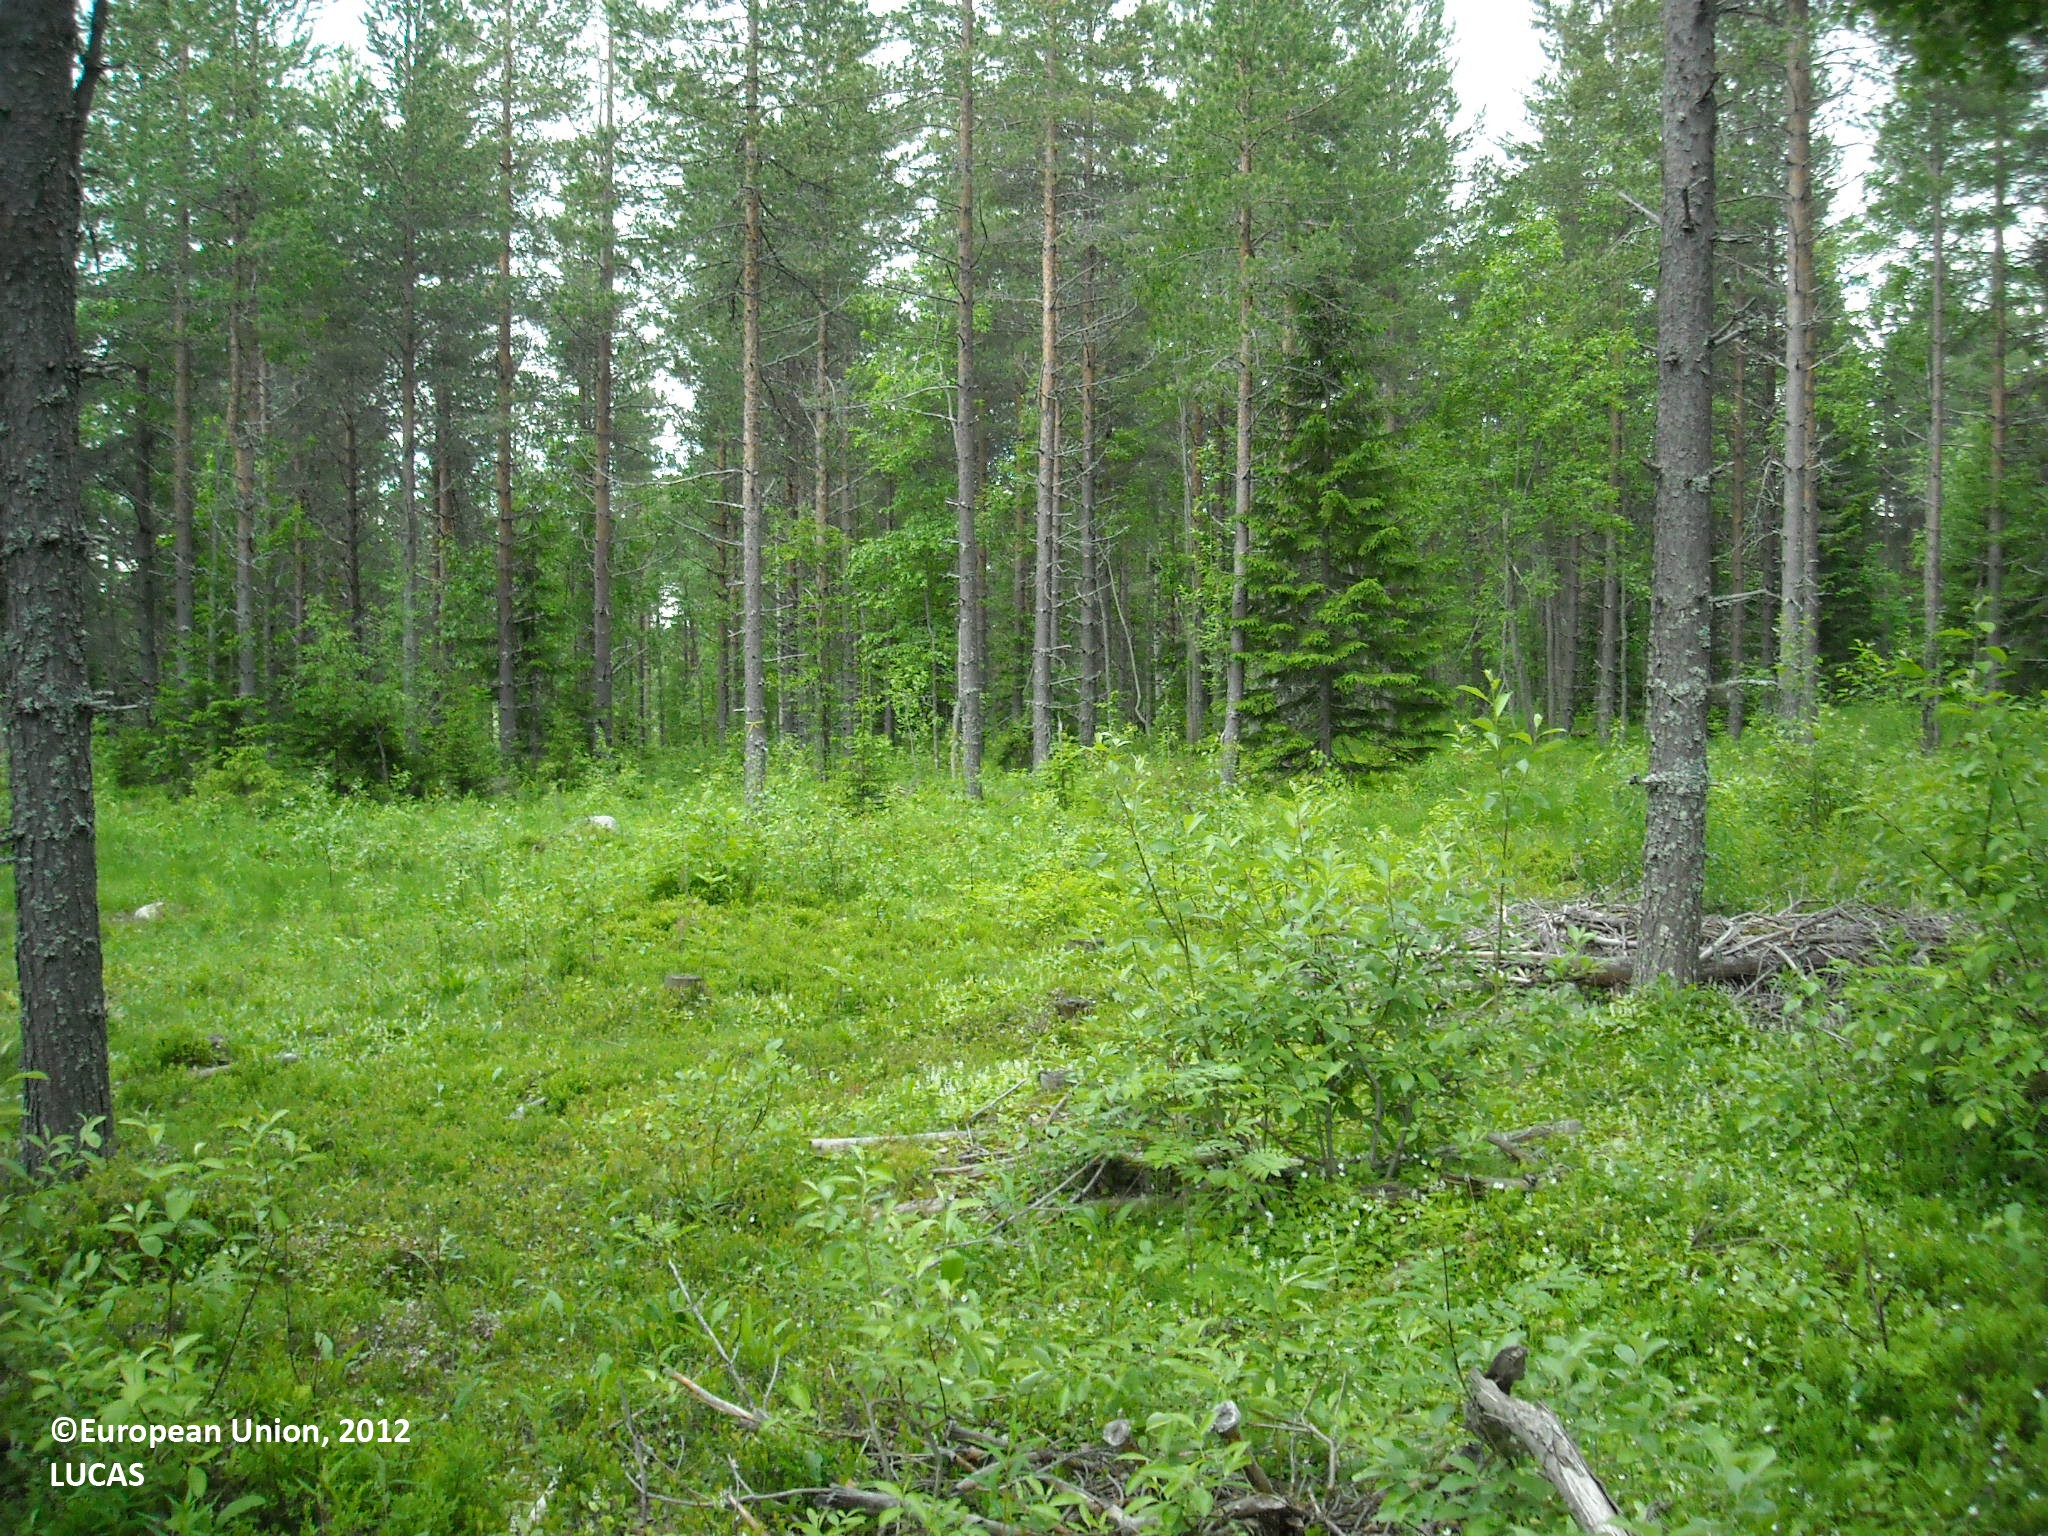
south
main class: Woodland
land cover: Pine dominated coniferous woodland
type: boreal forest
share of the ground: 25 - 50 %
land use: Forestry
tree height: > 5 m
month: June
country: FI
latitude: 64.7281
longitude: 27.8920
